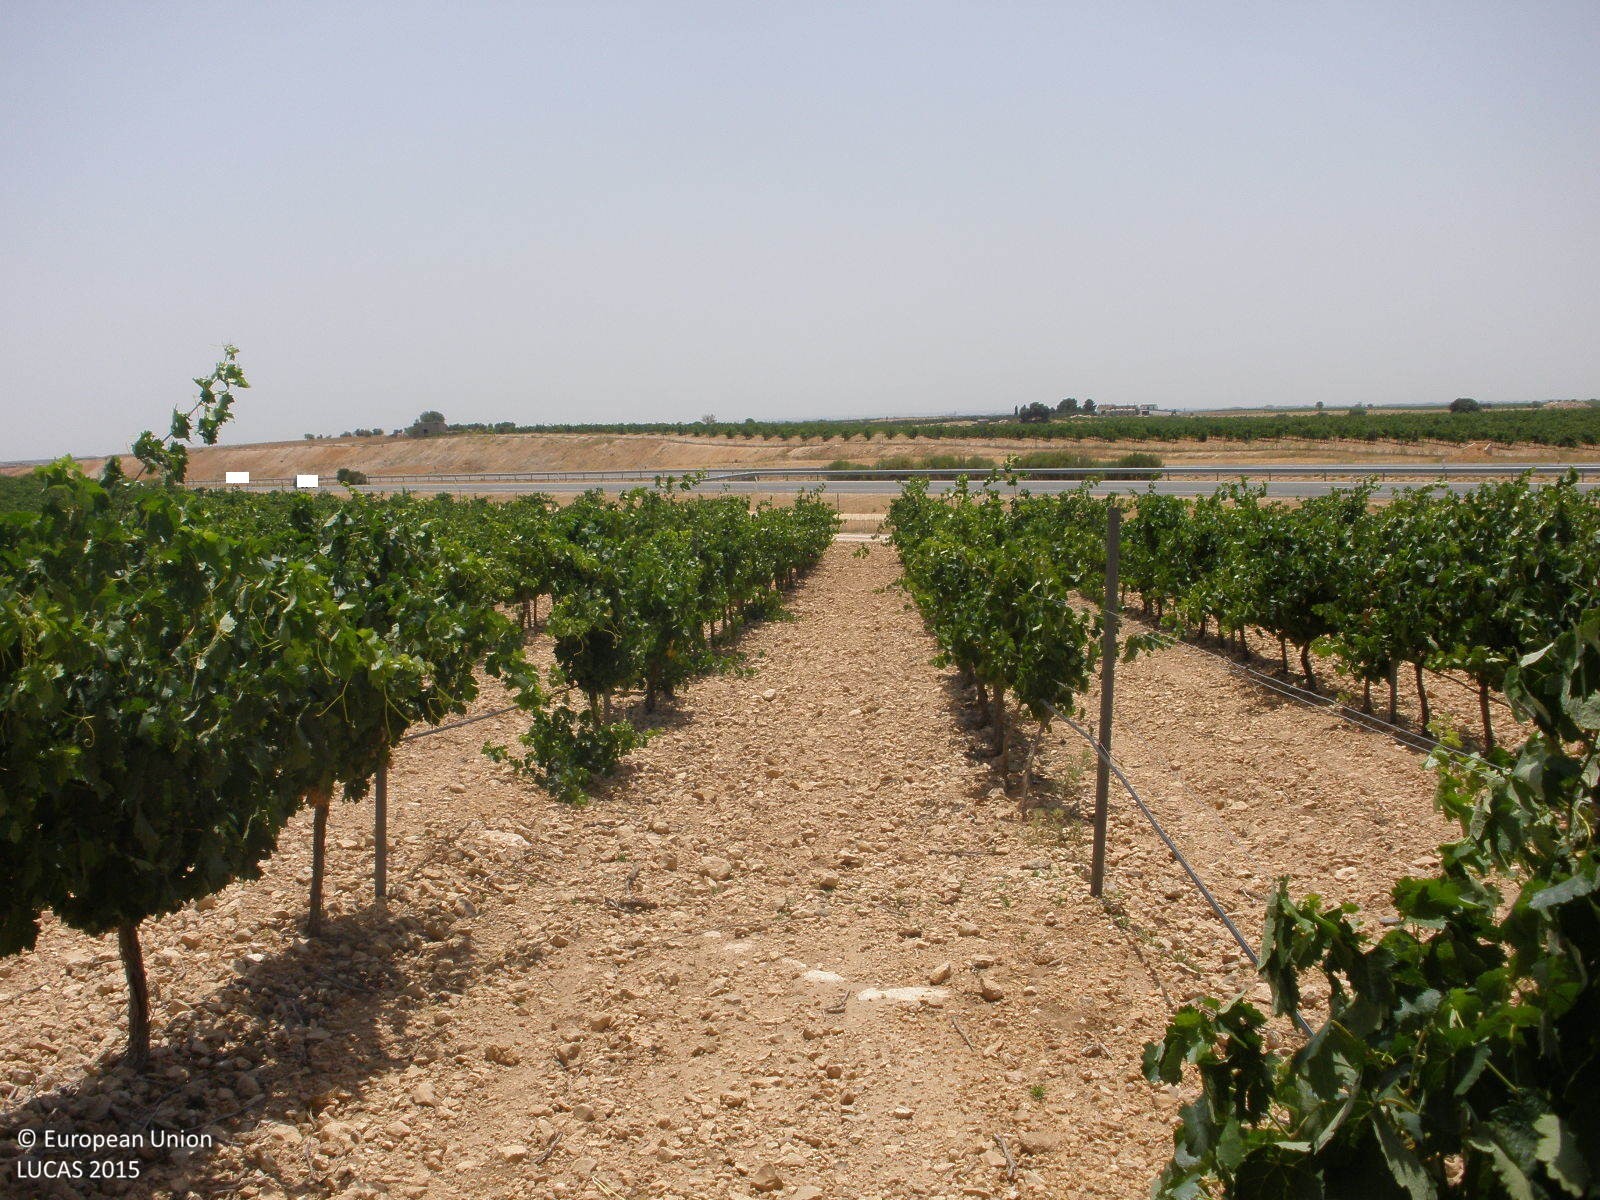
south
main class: Cropland
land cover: Vineyards
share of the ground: 25 - 50 %
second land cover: Other bare soil
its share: > 75 %
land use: Agriculture (excluding fallow land and kitchen gardens)
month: July
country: ES
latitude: 39.6759
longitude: -3.1130
